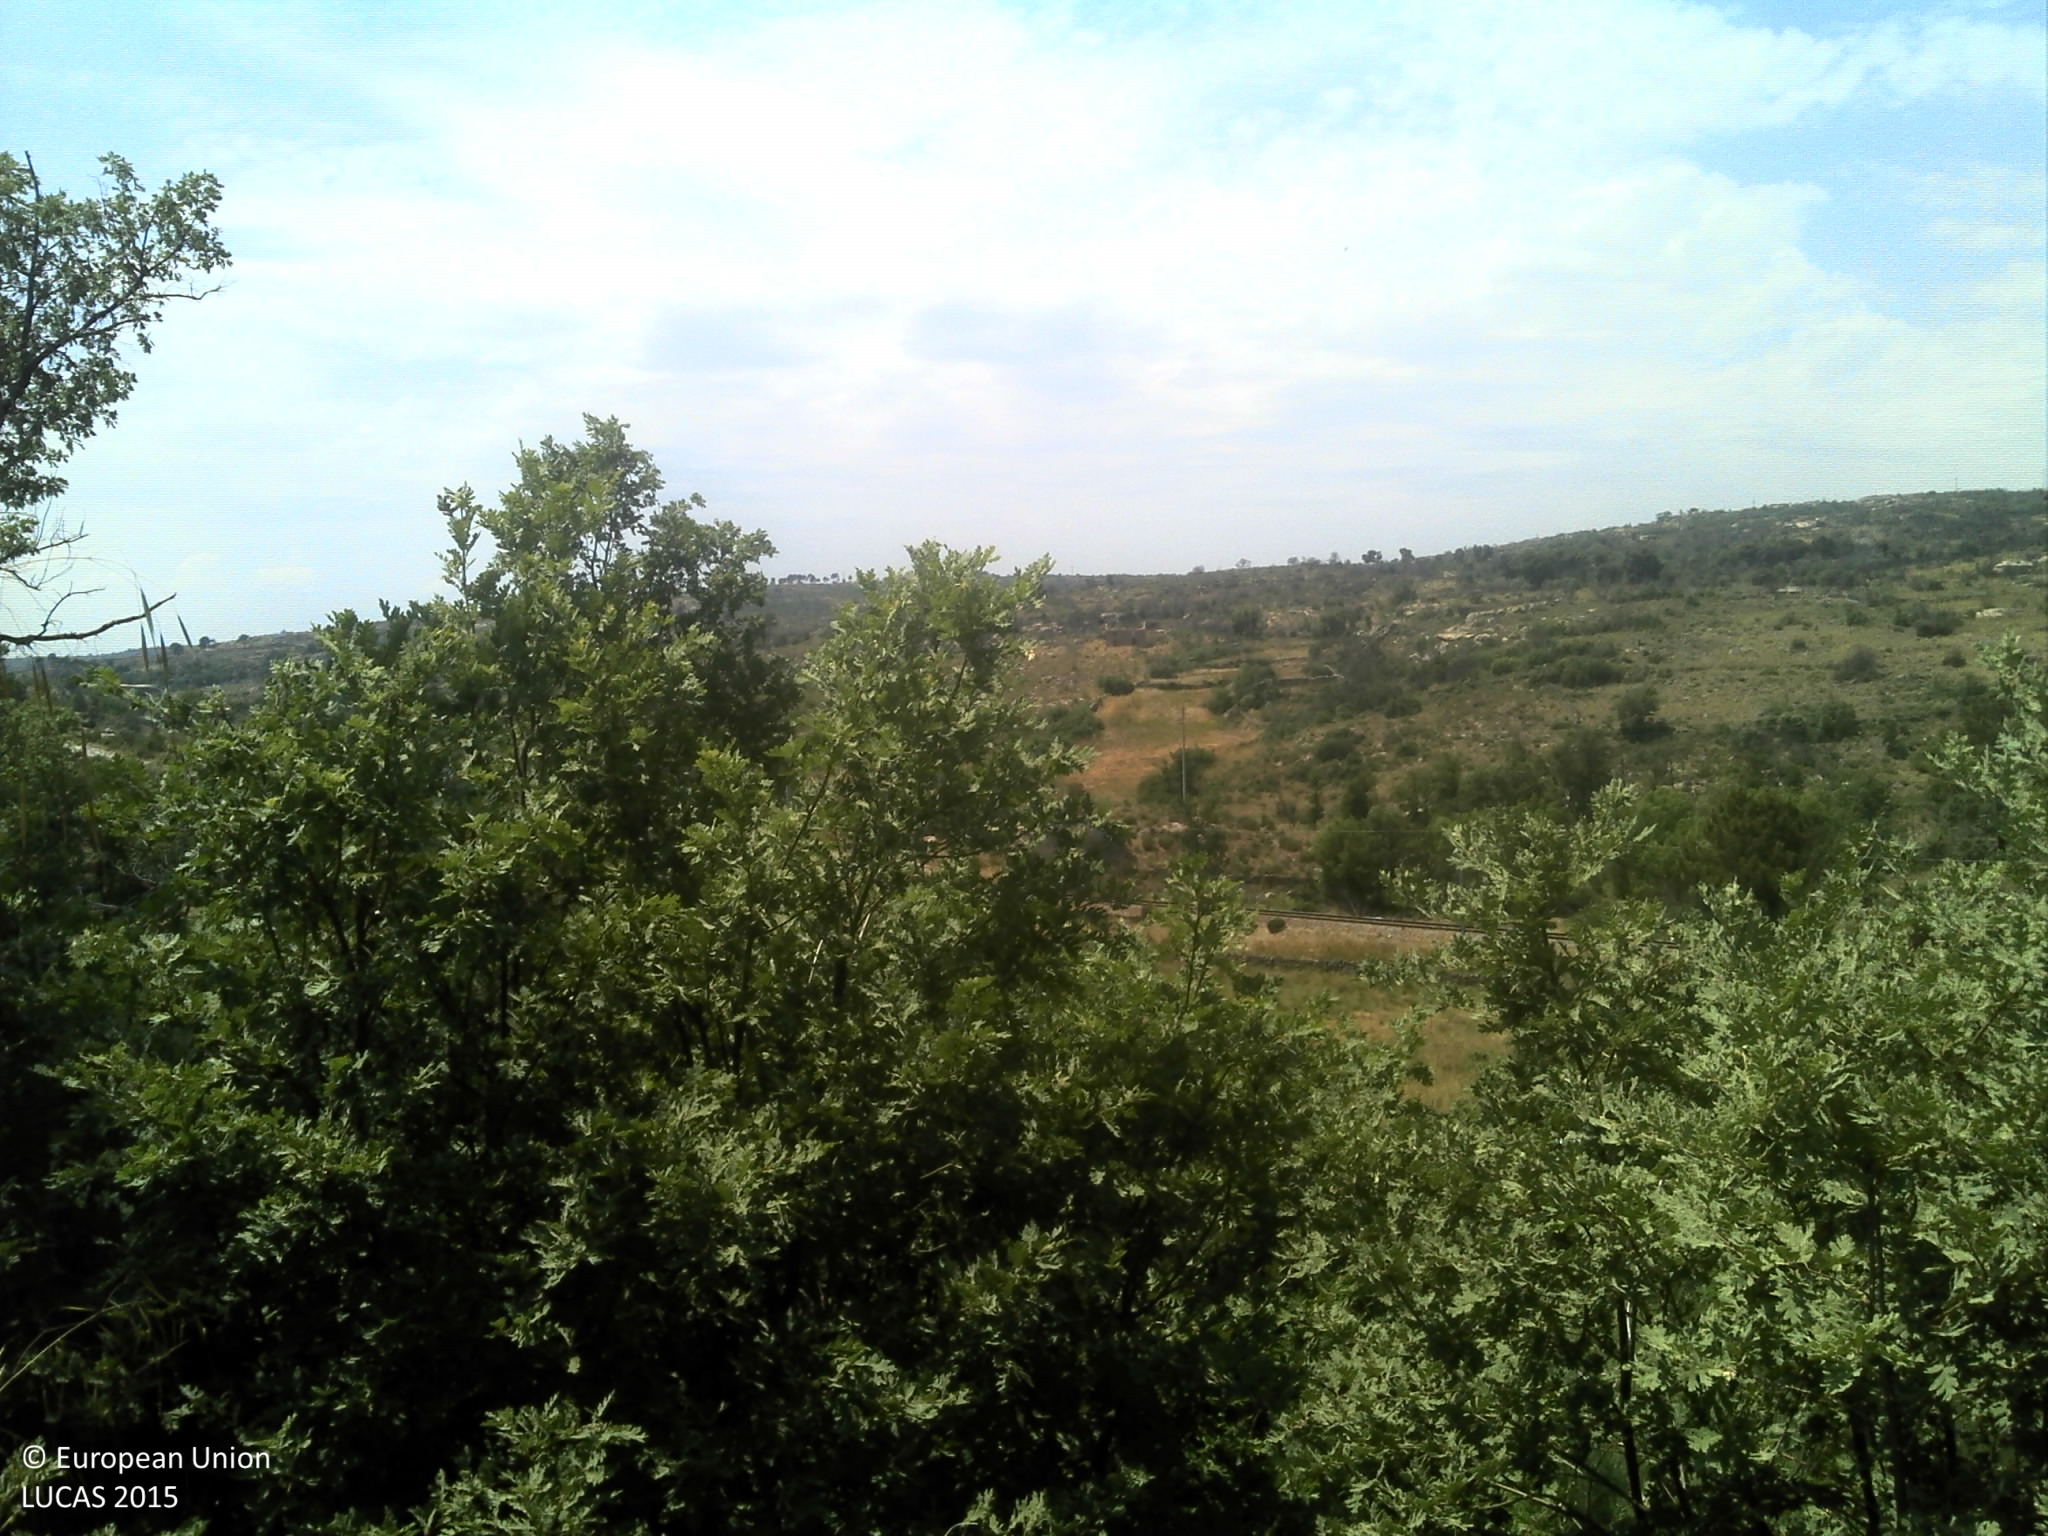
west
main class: Shrubland
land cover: Shrubland with sparse tree cover
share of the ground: 50 - 75 %
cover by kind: shrubs 70 %, herbaceous plants 15 %, unconsolidated bare surface 10 %, broadleaved forest trees 5 %
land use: Semi-natural and natural areas not in use
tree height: < 5 m
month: June
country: PT
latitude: 40.5245
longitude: -6.9906
